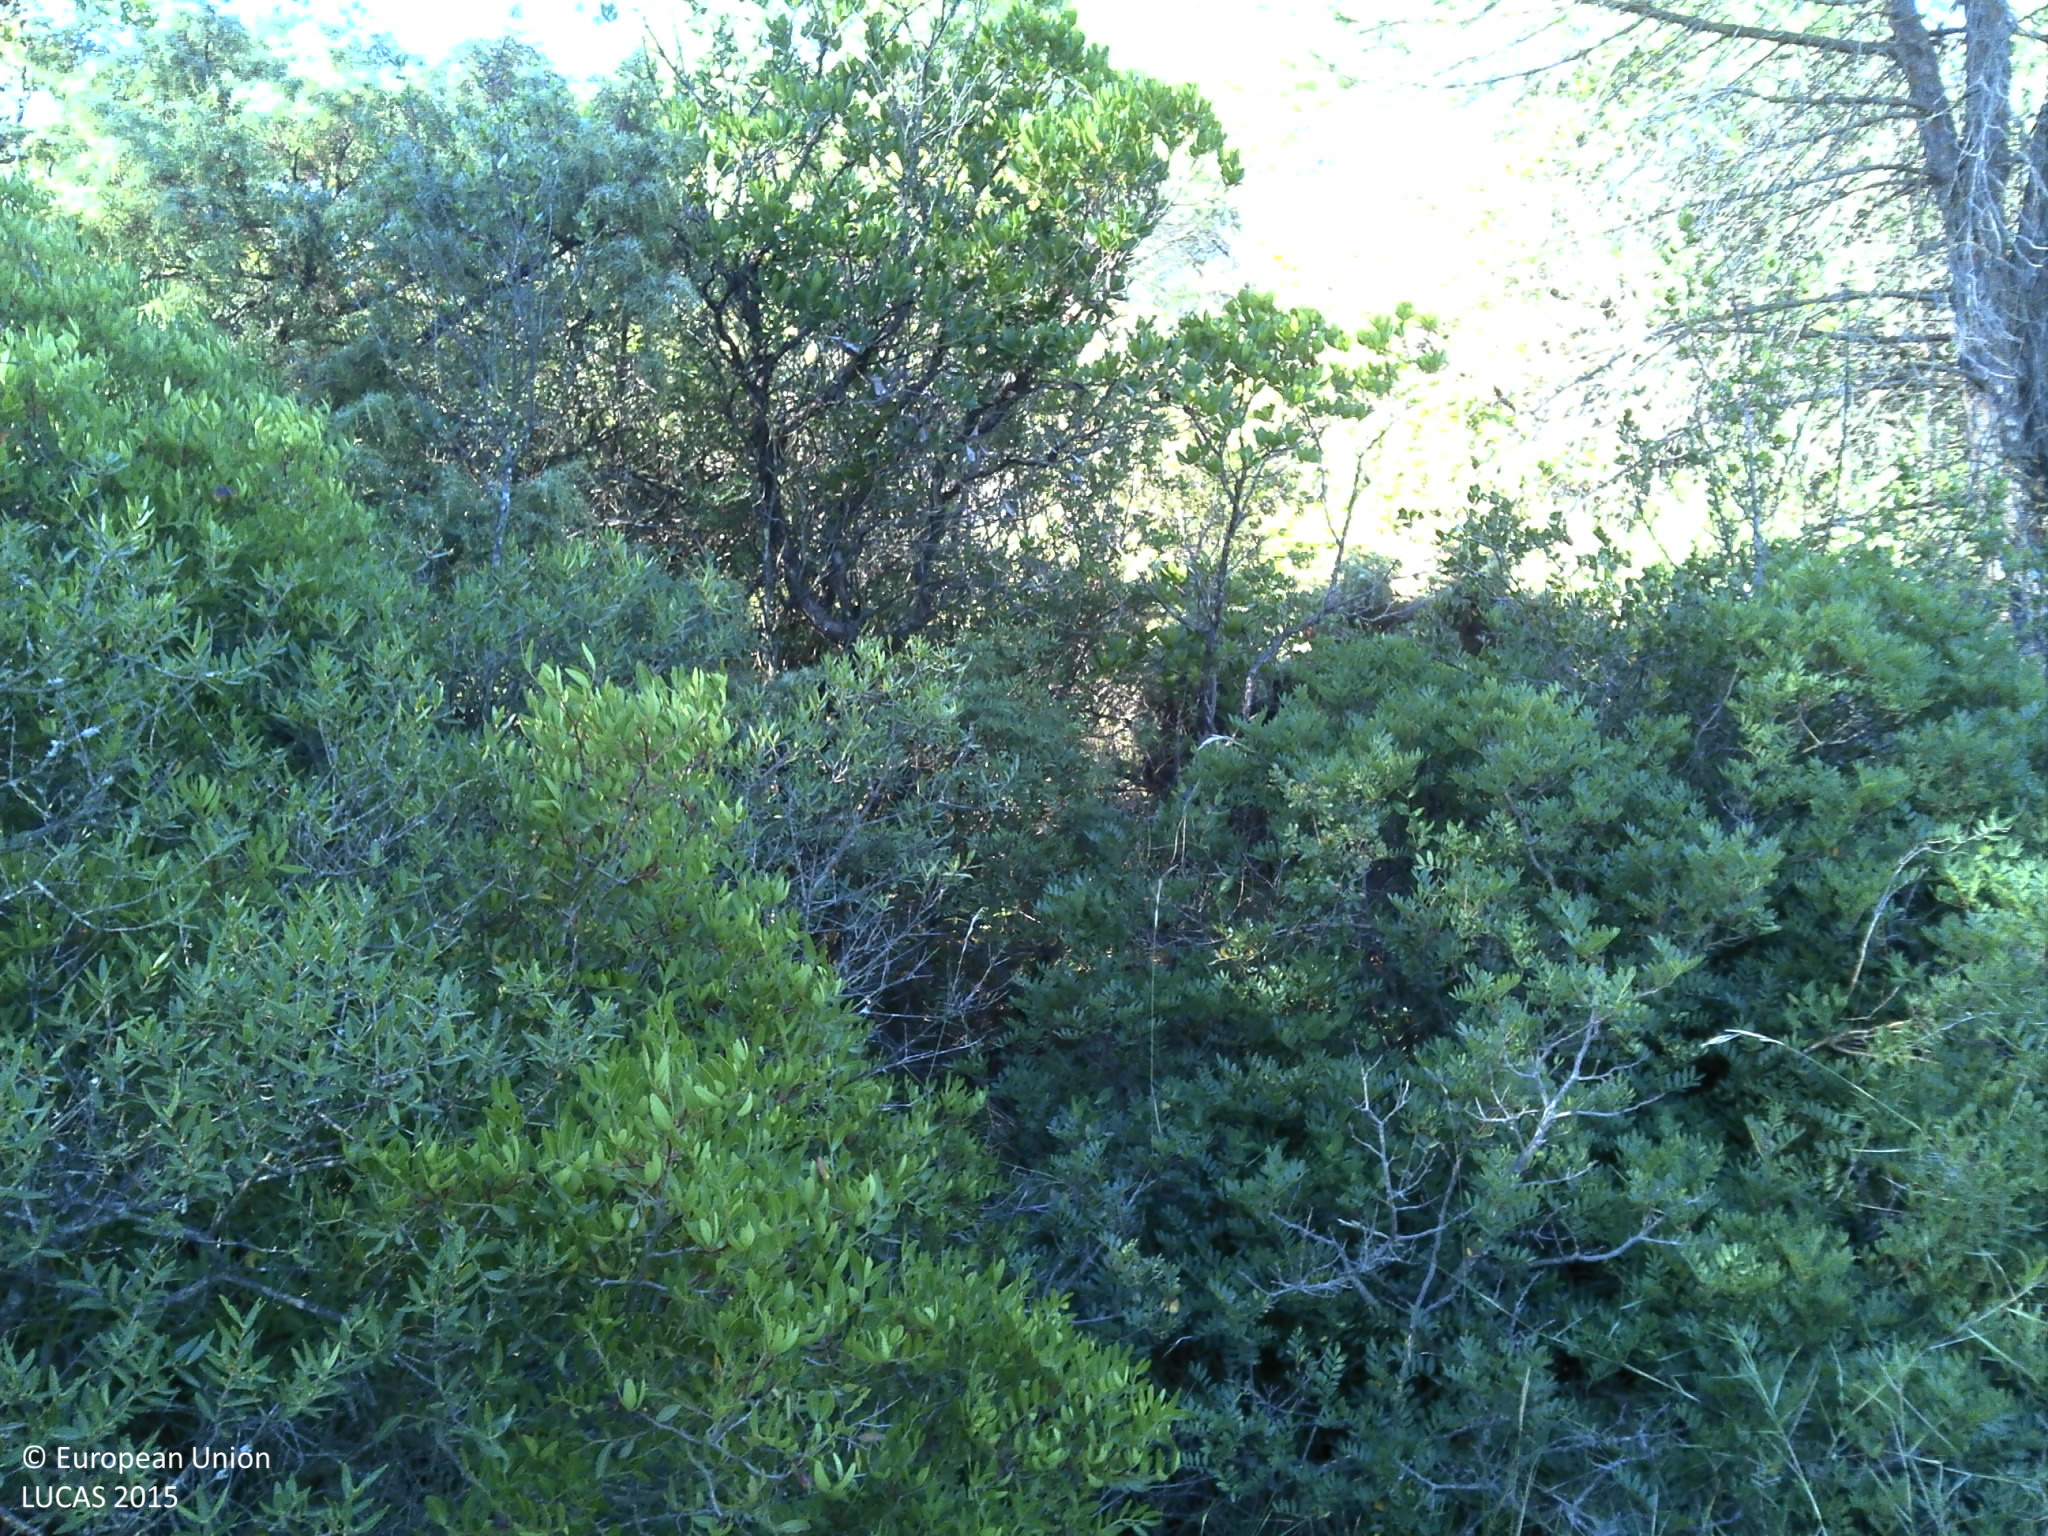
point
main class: Woodland
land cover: Pine dominated mixed woodland
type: coniferous forest of the mediterranean region
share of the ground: > 75 %
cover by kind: coniferous forest trees 45 %, broadleaved forest trees 30 %, shrubs 15 %, herbaceous plants 10 %
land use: Semi-natural and natural areas not in use
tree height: > 5 m
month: October
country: FR
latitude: 43.4903
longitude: 3.1458
